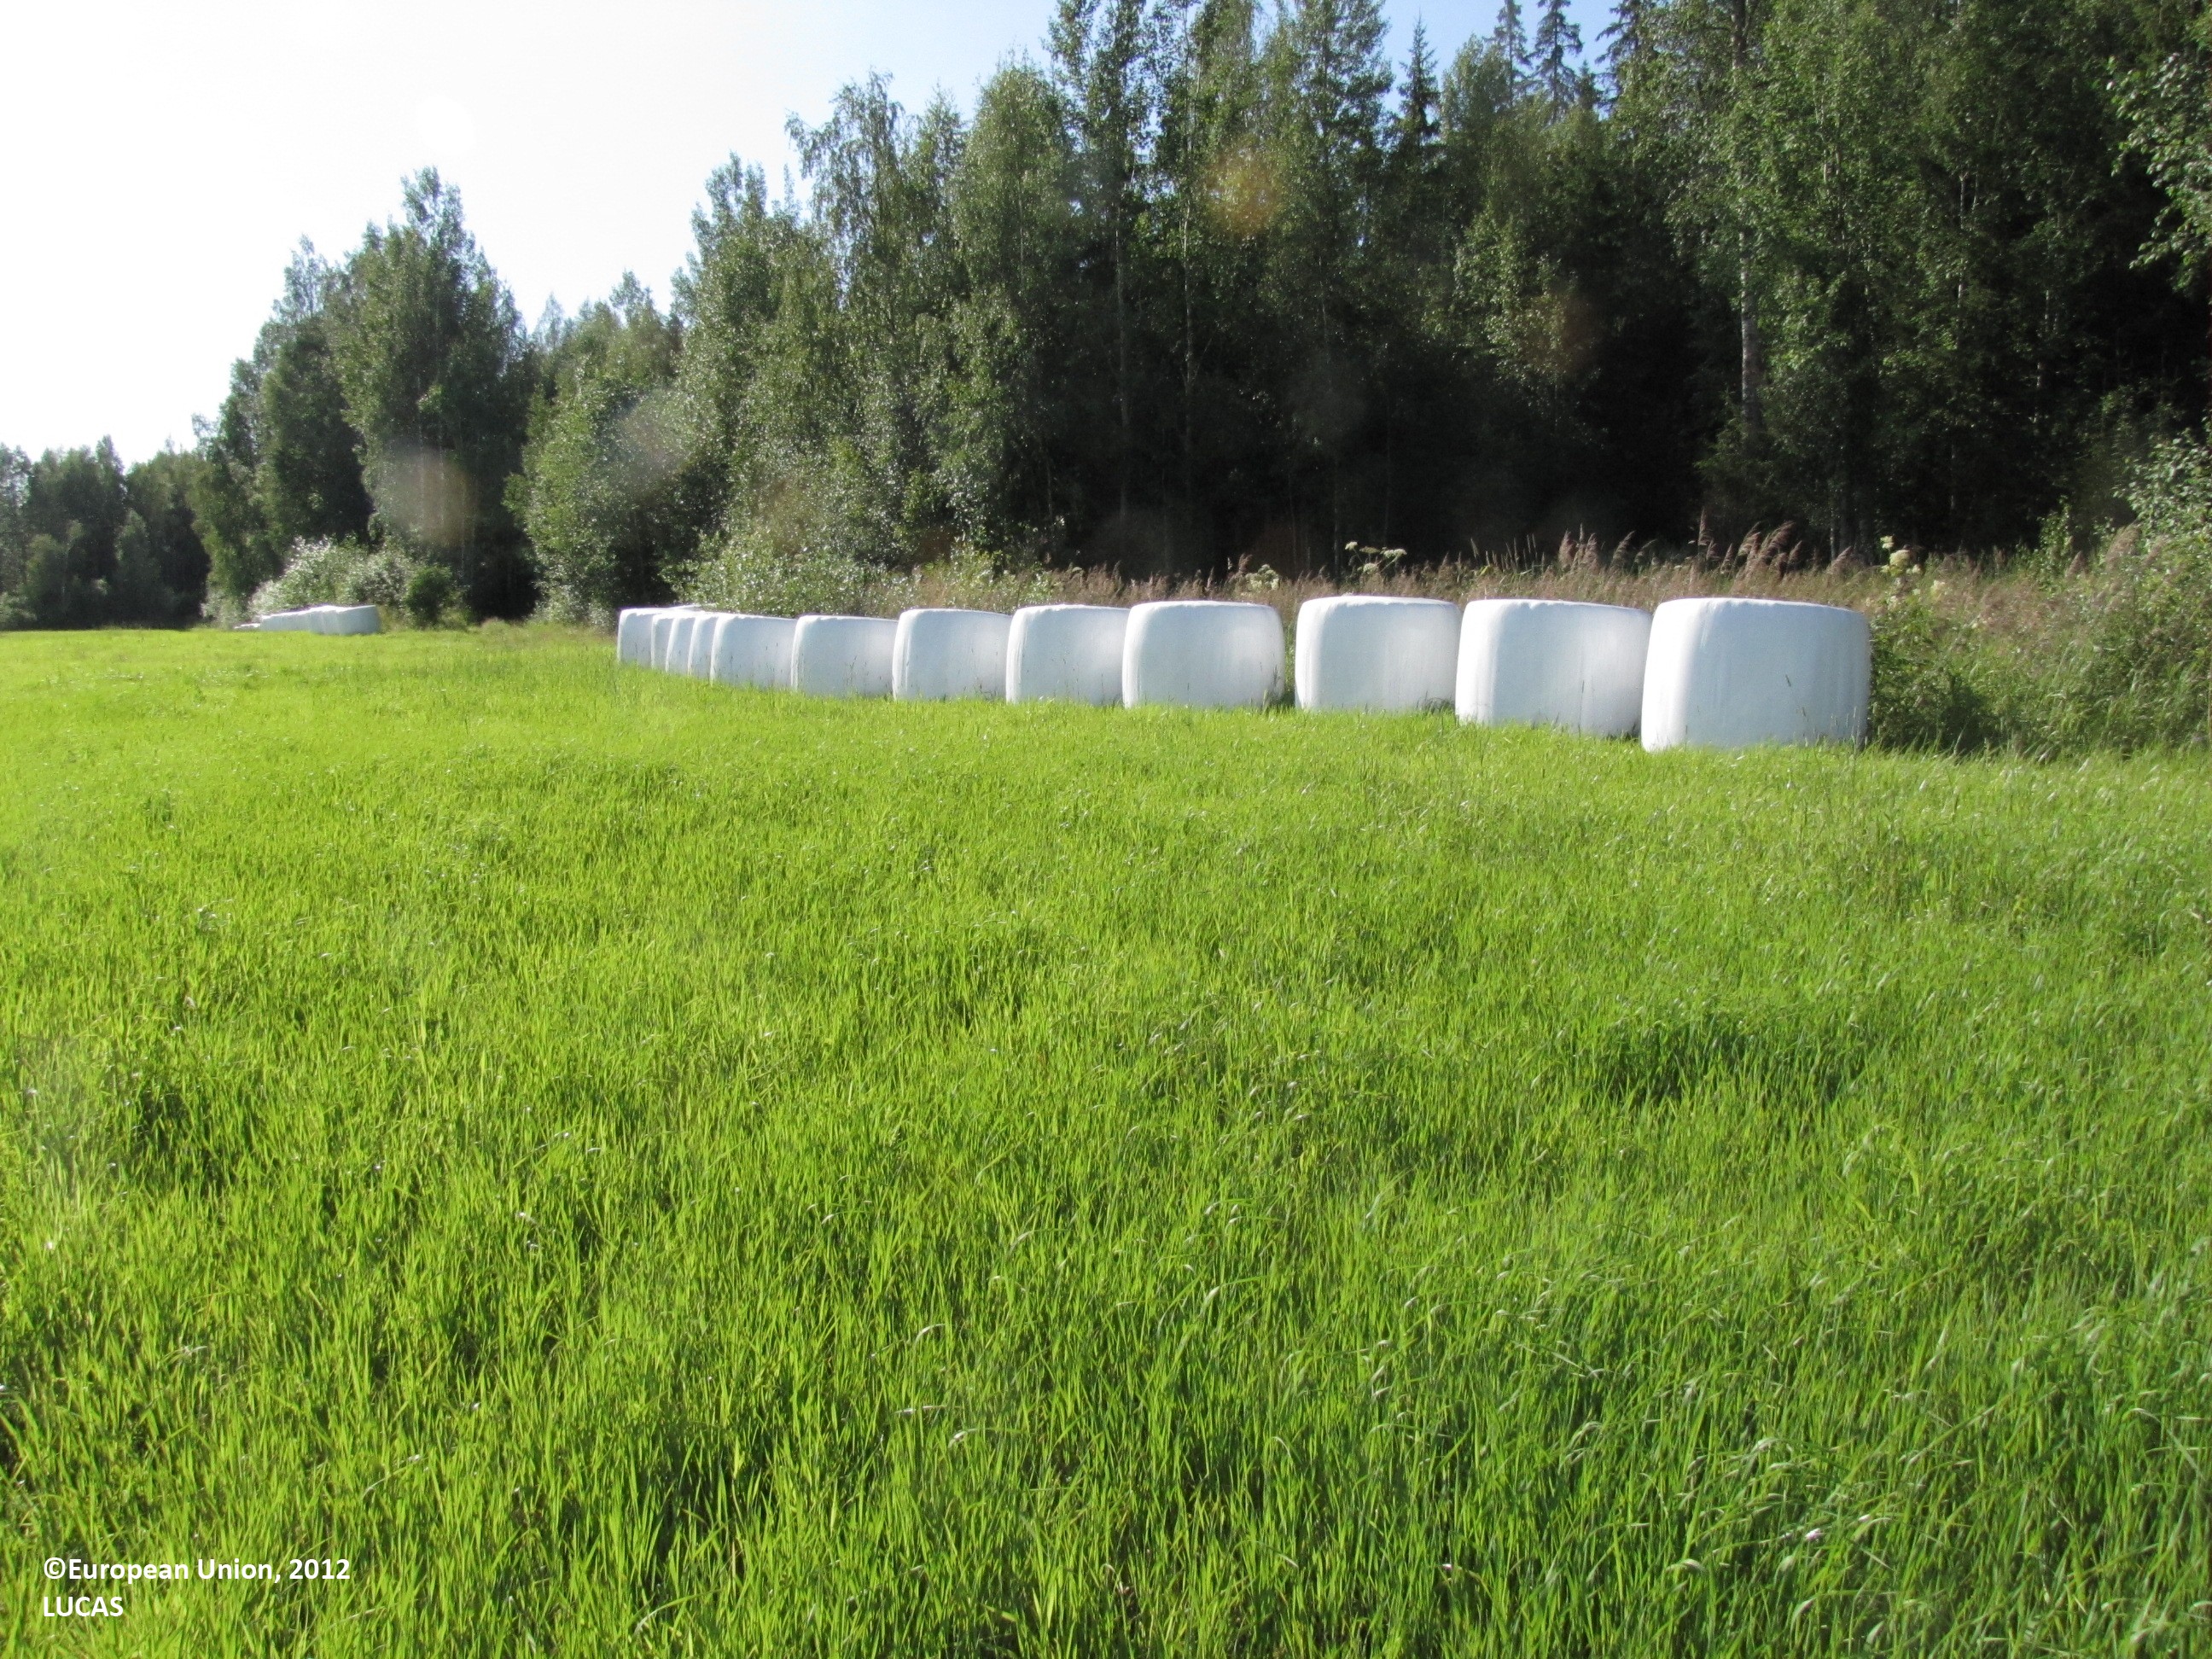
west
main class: Cropland
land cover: Temporary grasslands
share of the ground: > 75 %
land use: Agriculture (excluding fallow land and kitchen gardens)
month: July
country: FI
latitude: 62.1296
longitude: 23.0875
